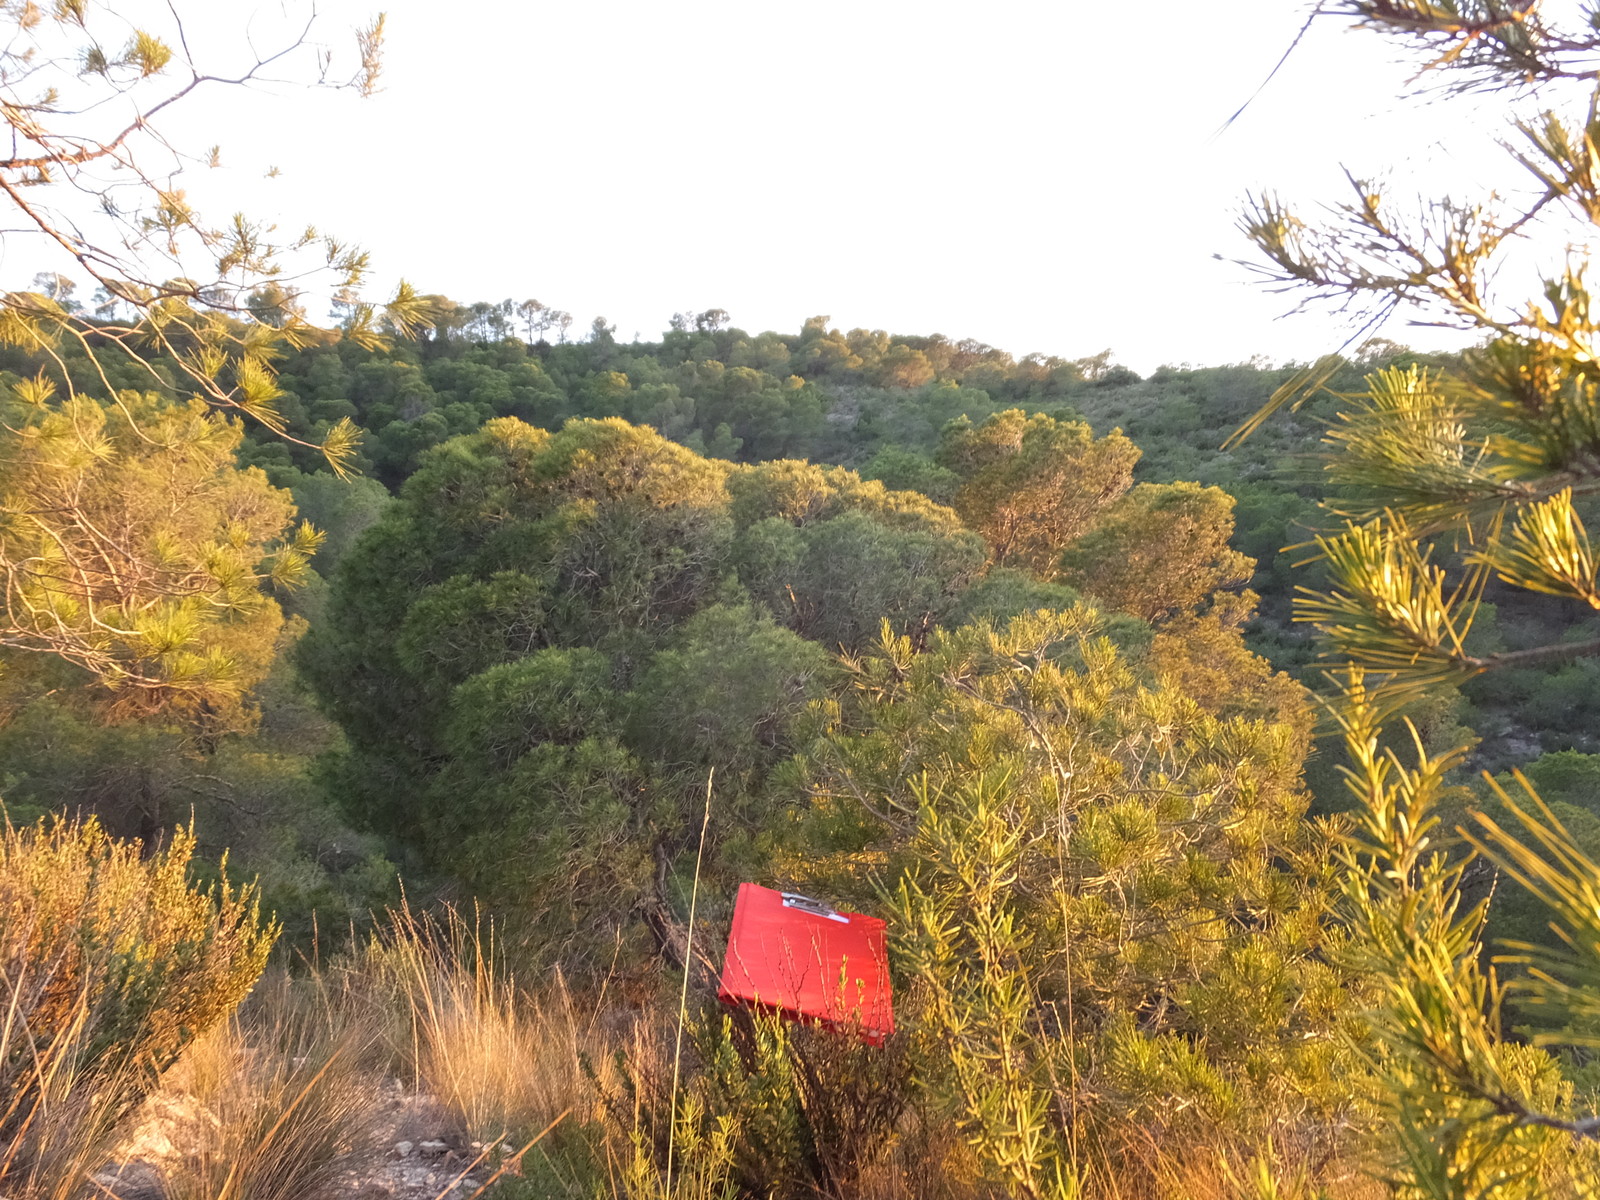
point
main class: Woodland
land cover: Pine dominated mixed woodland
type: coniferous forest of the mediterranean region
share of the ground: 25 - 50 %
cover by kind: shrubs 50 %, coniferous forest trees 25 %, broadleaved forest trees 15 %, herbaceous plants 10 %
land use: Forestry
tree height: < 5 m
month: June
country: ES
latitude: 41.3494
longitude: -0.2575
